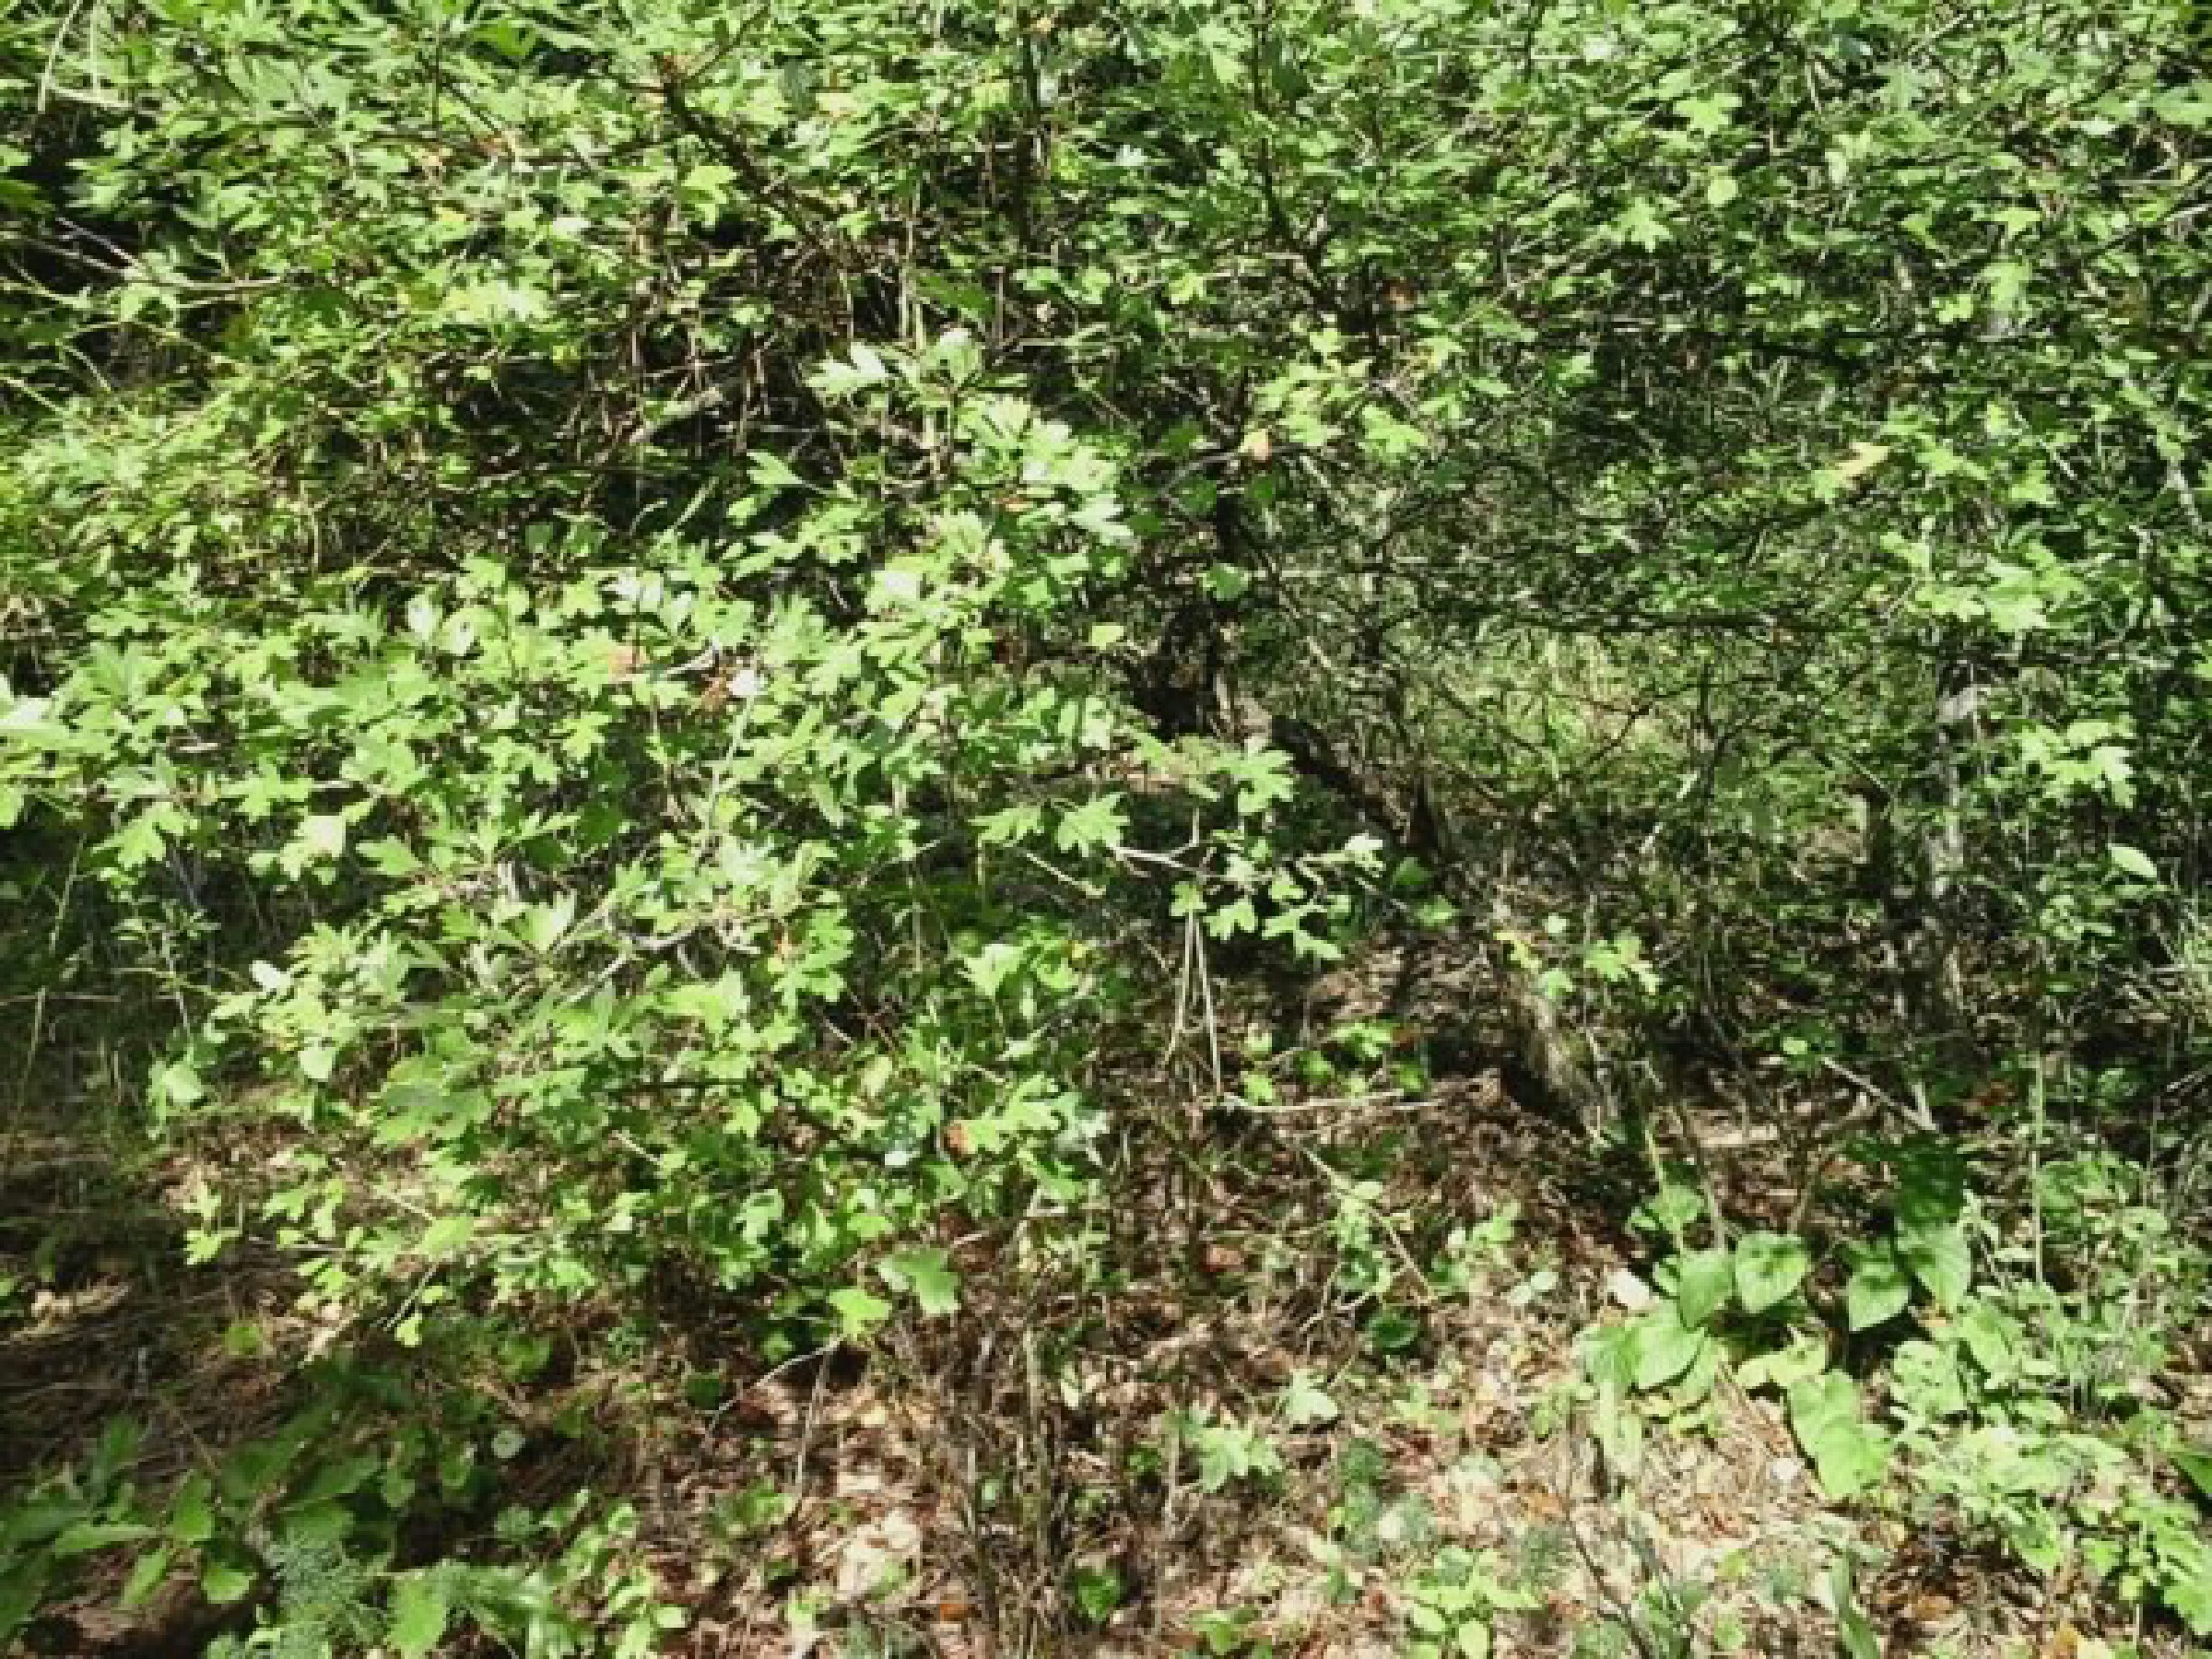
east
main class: Woodland
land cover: Pine dominated mixed woodland
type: hemiboreal forest and nemoral coniferous forest and mixed broadleaved-coniferous forest
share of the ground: > 75 %
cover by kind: coniferous forest trees 60 %, broadleaved forest trees 40 %
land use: Forestry
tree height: > 5 m
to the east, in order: Pine dominated mixed woodland; Broadleaved woodland; Tracks; Broadleaved woodland; Tracks; Broadleaved woodland
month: August
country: HU
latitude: 47.9806
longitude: 19.4412
